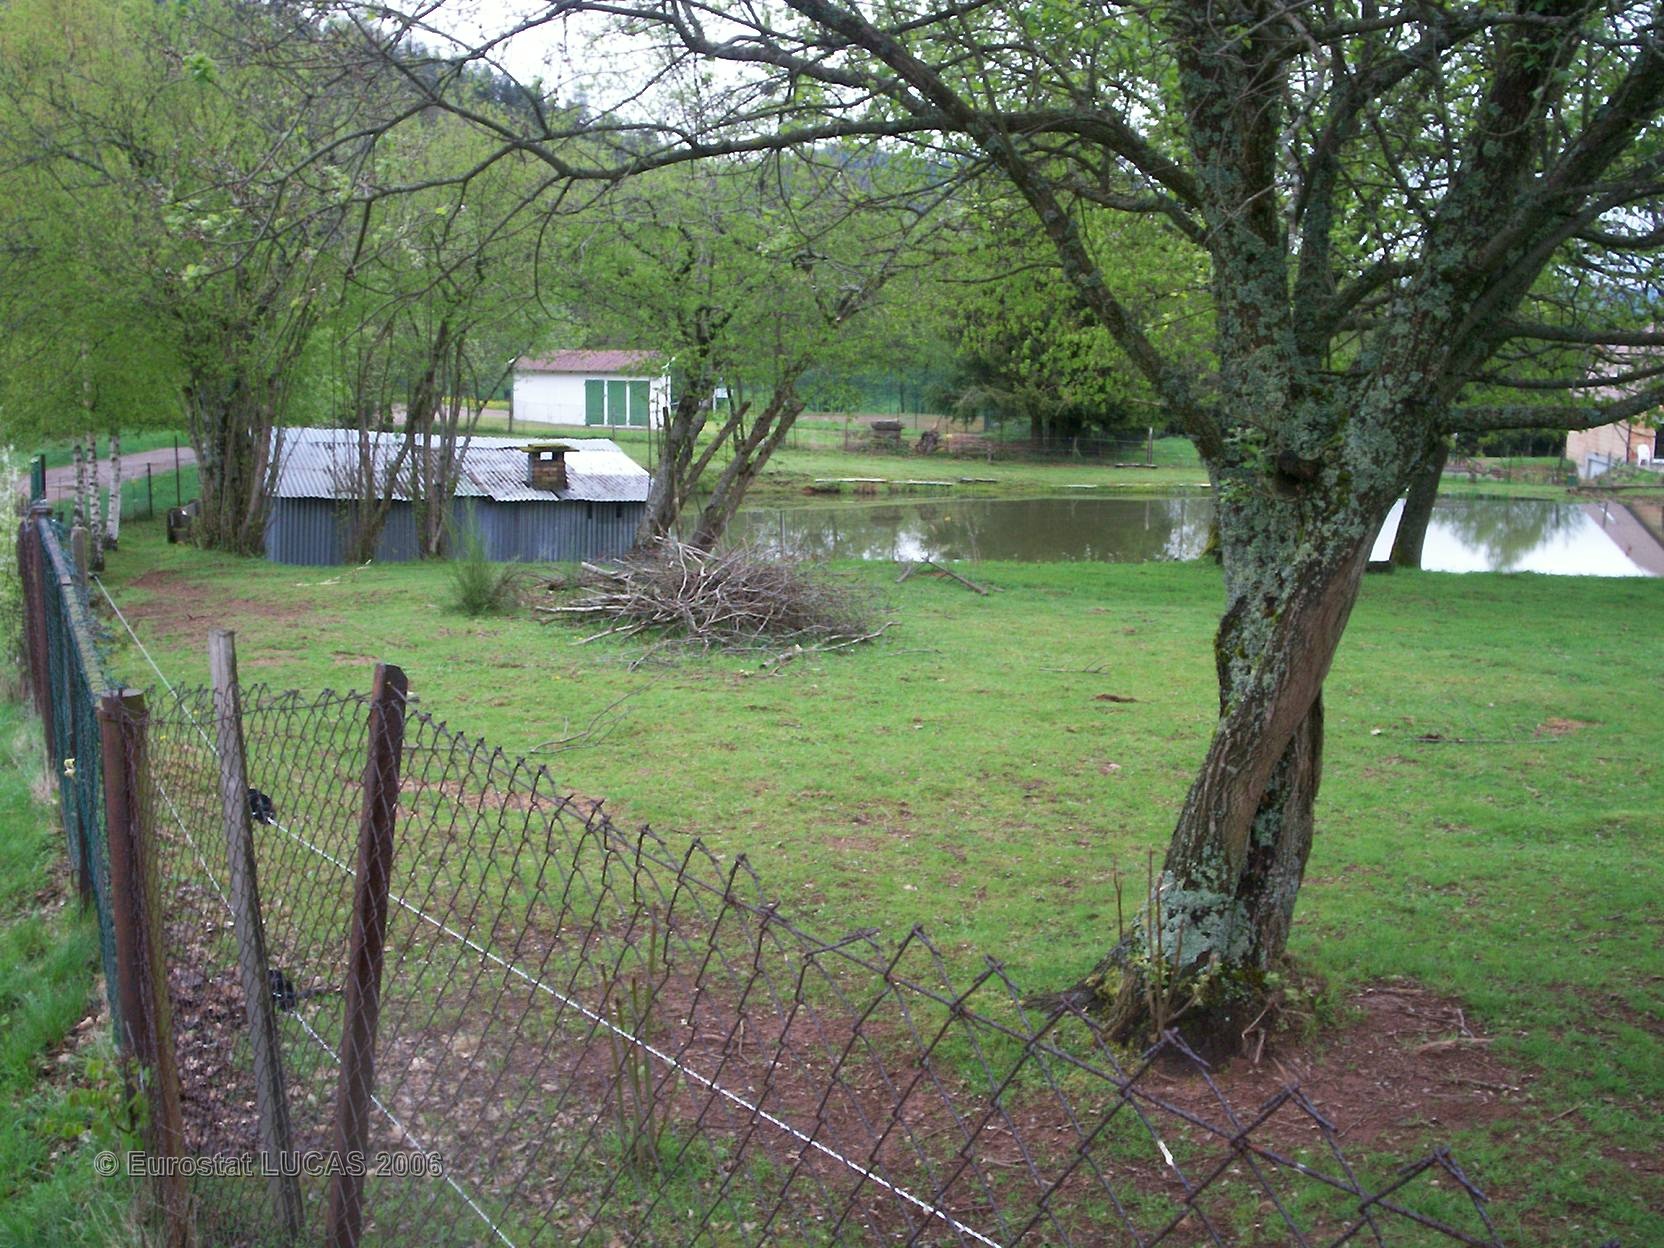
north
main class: Grassland
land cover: Grassland with sparse tree/shrub cover
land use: Amenities, museums, leisure
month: May
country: FR
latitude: 48.3475
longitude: 7.0998
